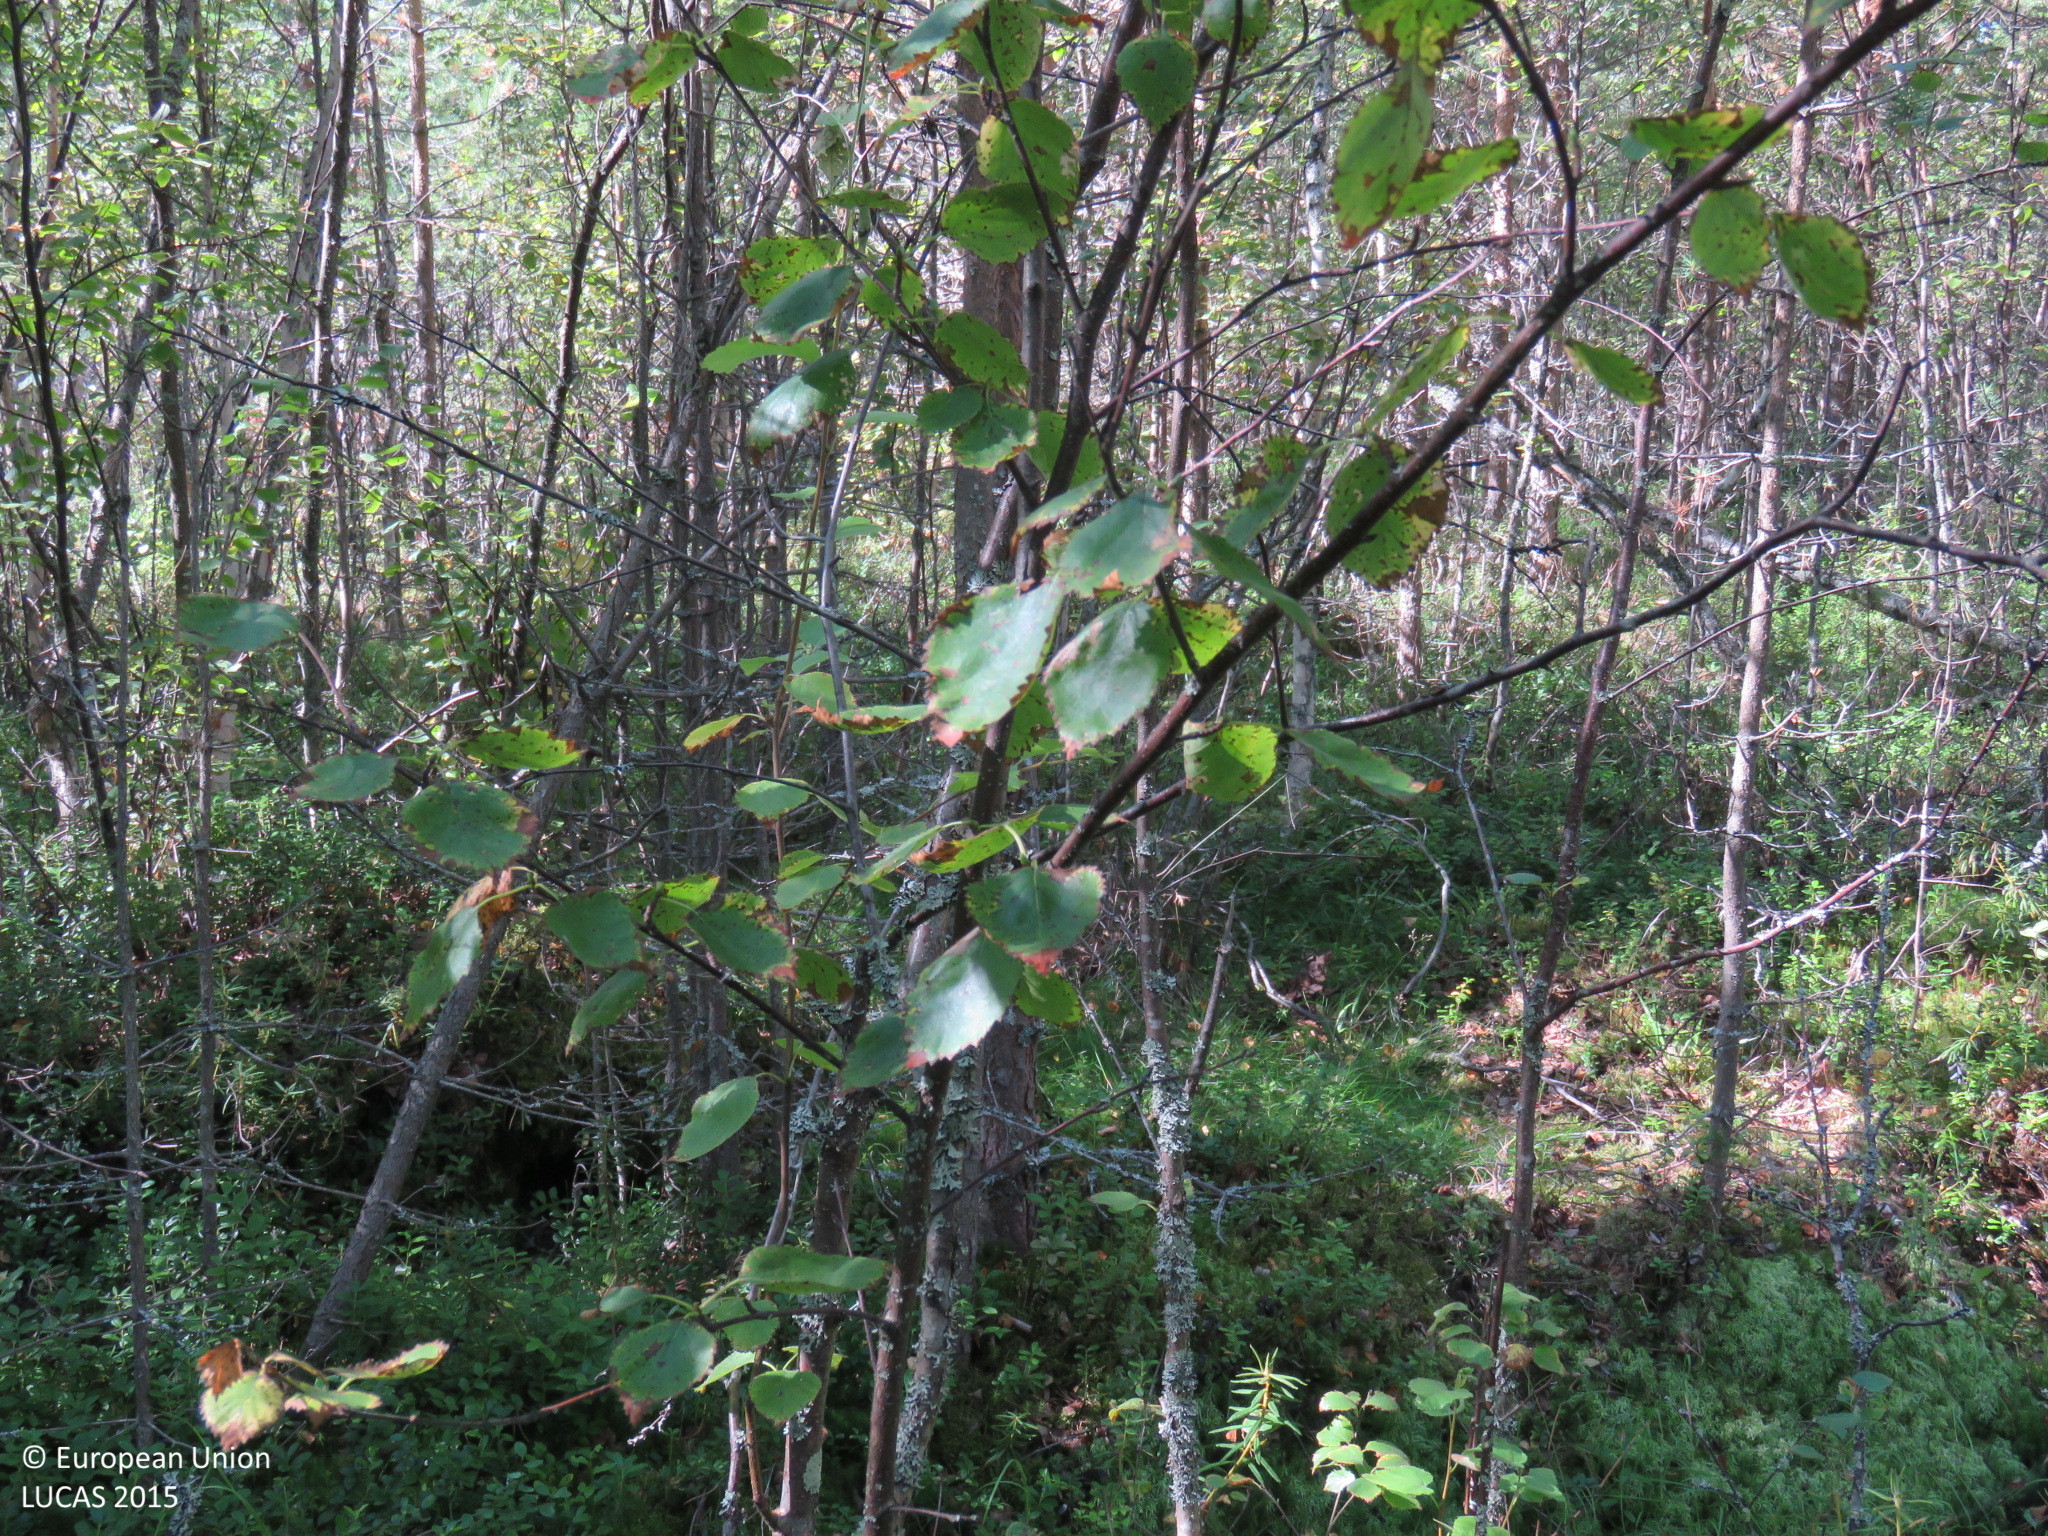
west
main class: Woodland
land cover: Pine dominated mixed woodland
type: boreal forest
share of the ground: > 75 %
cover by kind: broadleaved forest trees 55 %, coniferous forest trees 40 %, shrubs 5 %
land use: Forestry
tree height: > 5 m
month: August
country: FI
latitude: 64.9866
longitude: 24.8438
